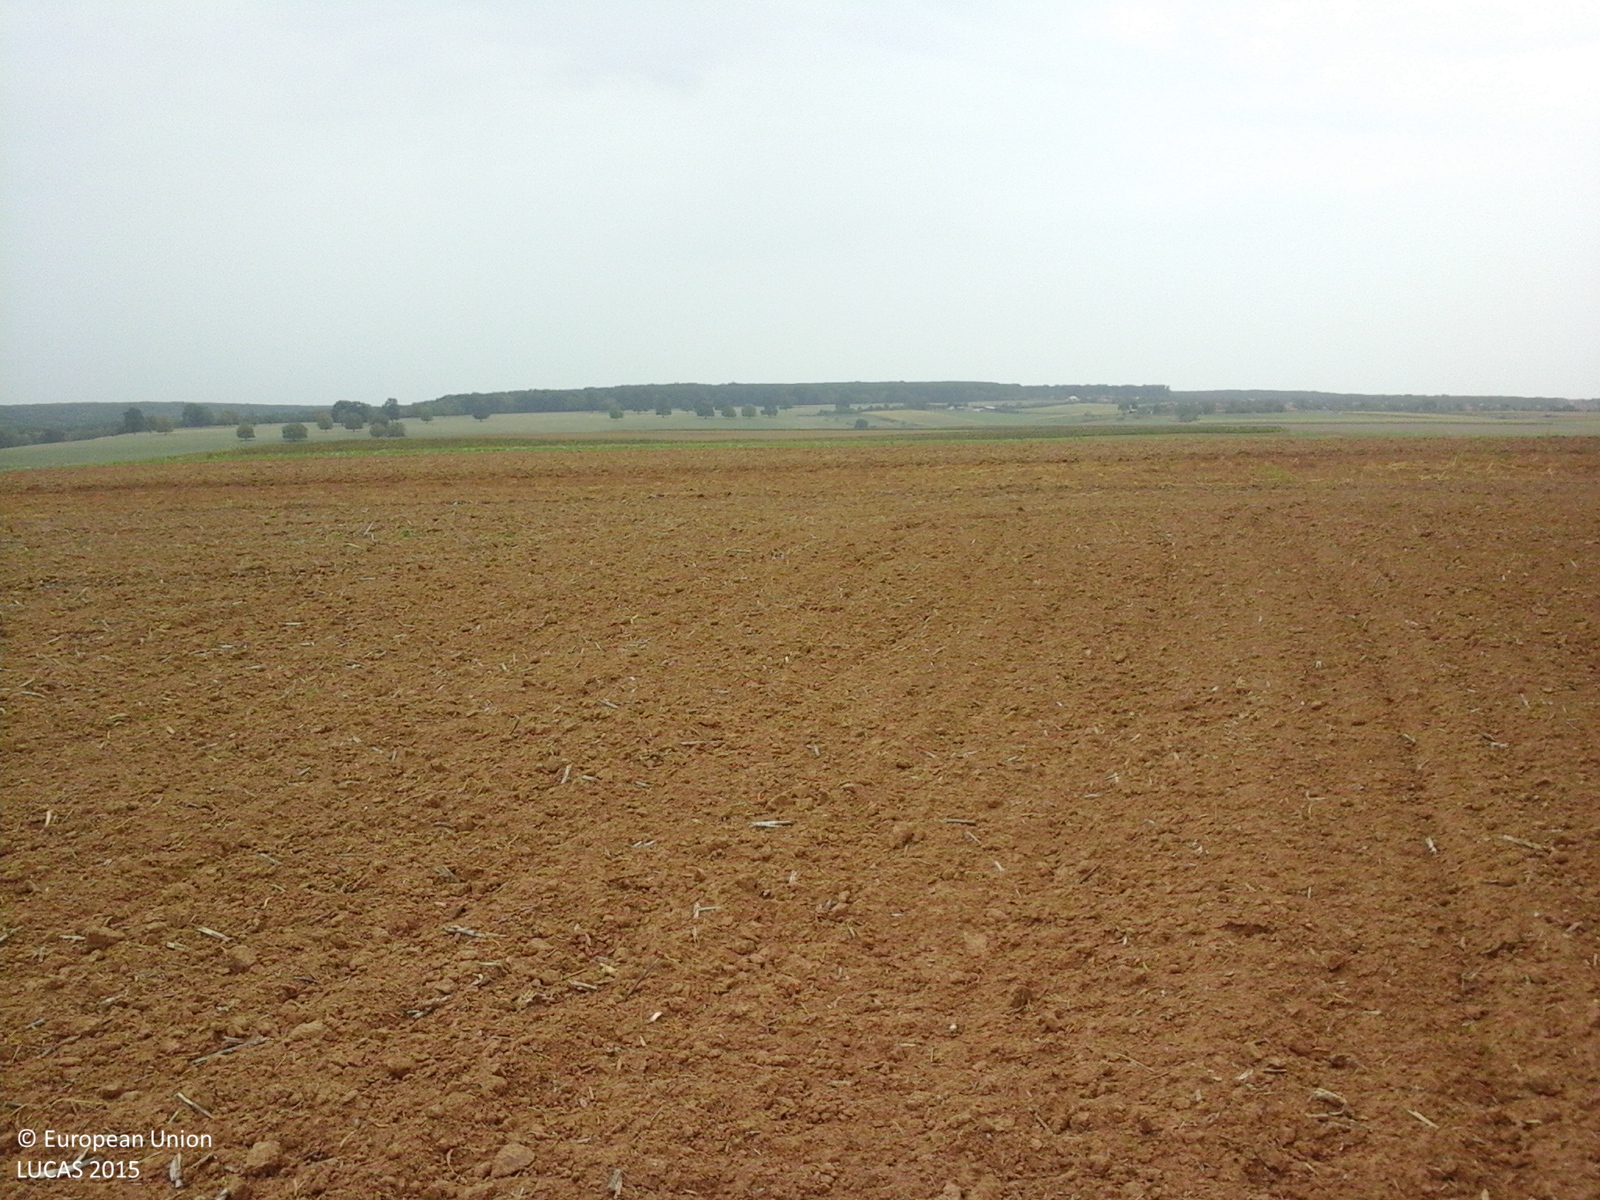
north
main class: Cropland
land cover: Rape and turnip rape
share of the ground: < 10 %
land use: Agriculture (excluding fallow land and kitchen gardens)
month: September
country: RO
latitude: 47.3764
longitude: 22.3850
